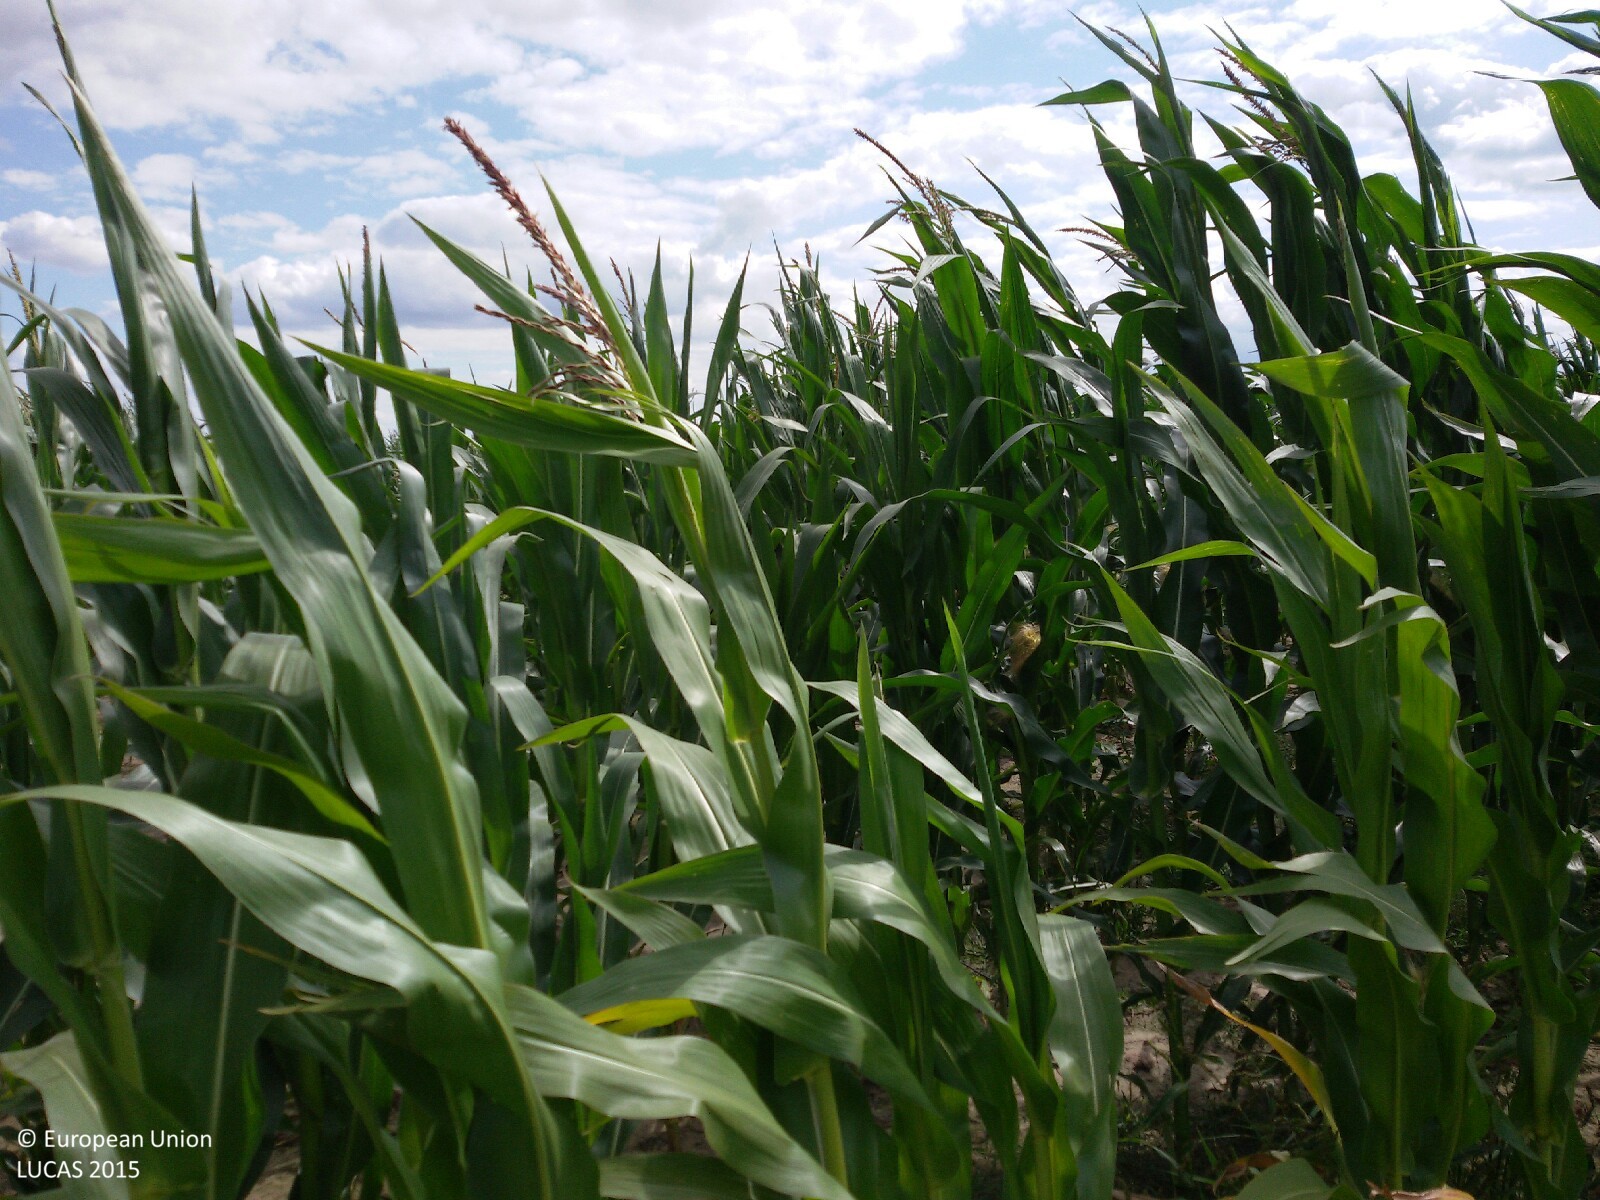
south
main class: Cropland
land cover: Maize
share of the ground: > 75 %
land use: Agriculture (excluding fallow land and kitchen gardens)
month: July
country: PL
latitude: 52.0447
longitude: 21.7629
